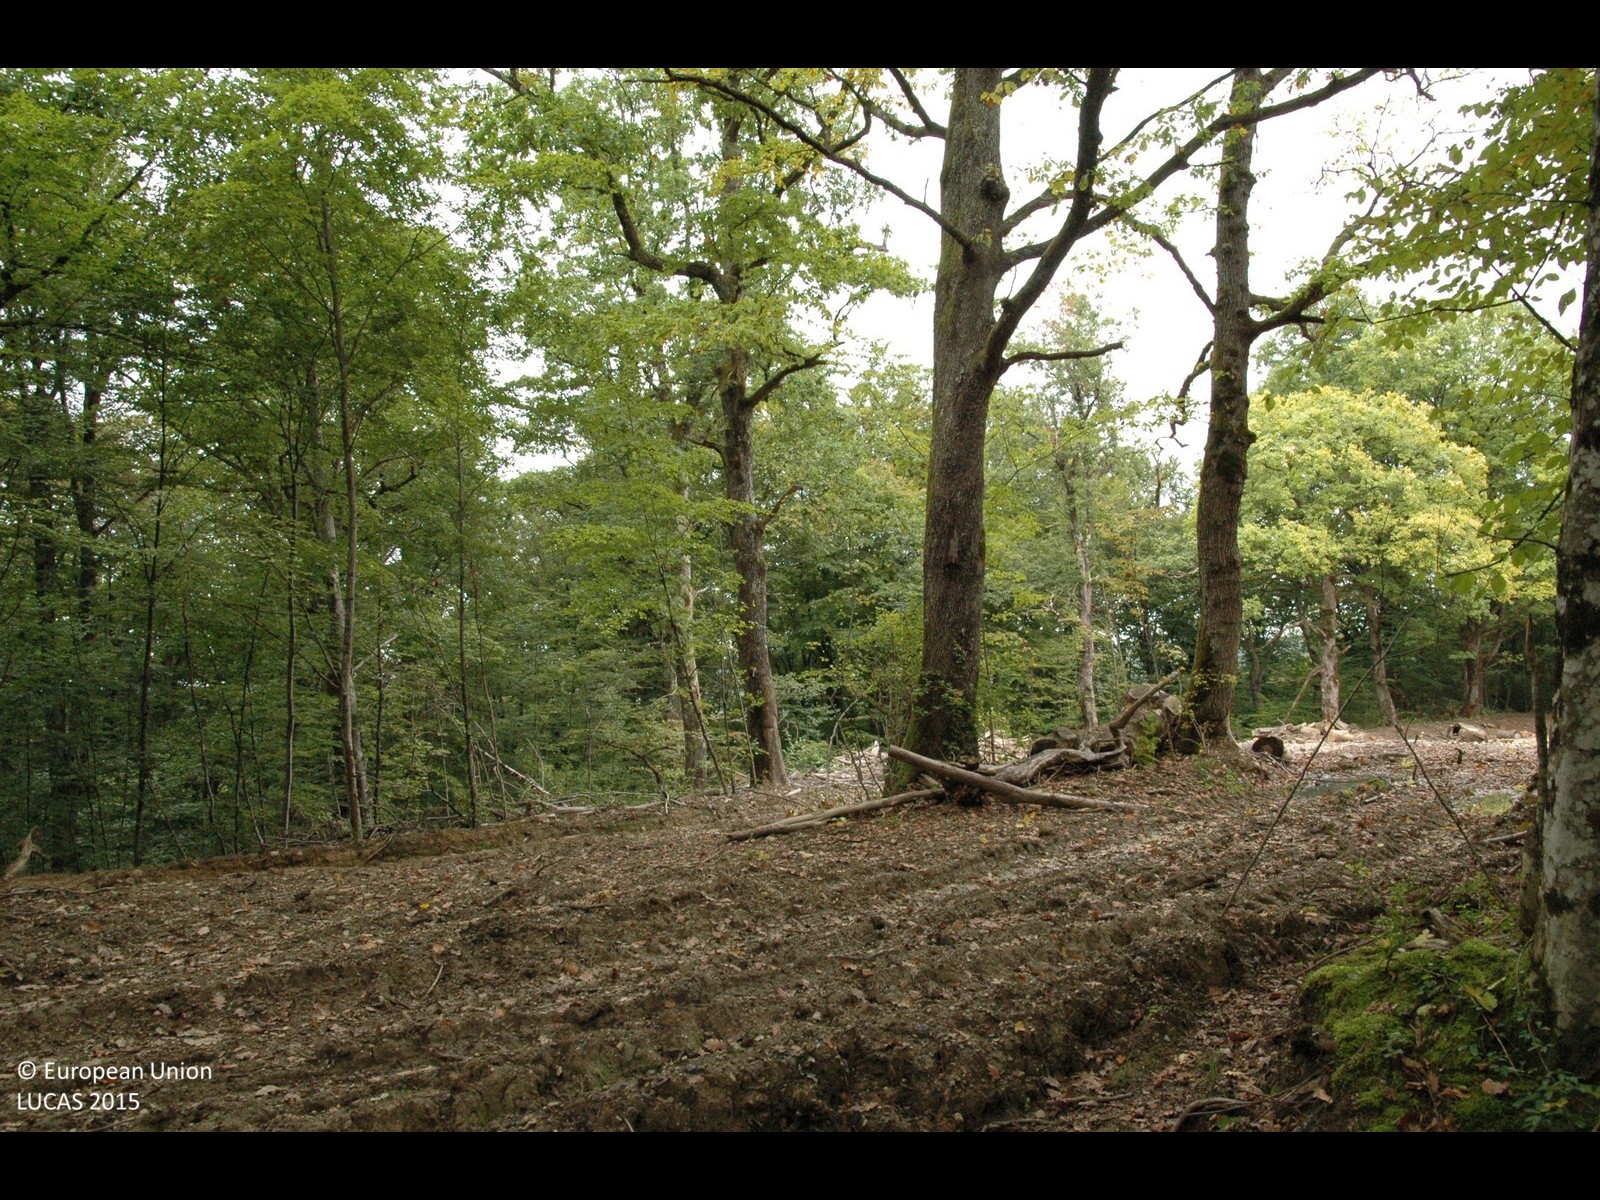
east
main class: Woodland
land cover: Broadleaved woodland
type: mesophytic deciduous forest
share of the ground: > 75 %
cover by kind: broadleaved forest trees 100 %
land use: Forestry
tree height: > 5 m
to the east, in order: Broadleaved woodland; Rivers and streams; Broadleaved woodland
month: September
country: HR
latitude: 45.2646
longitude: 15.6161
